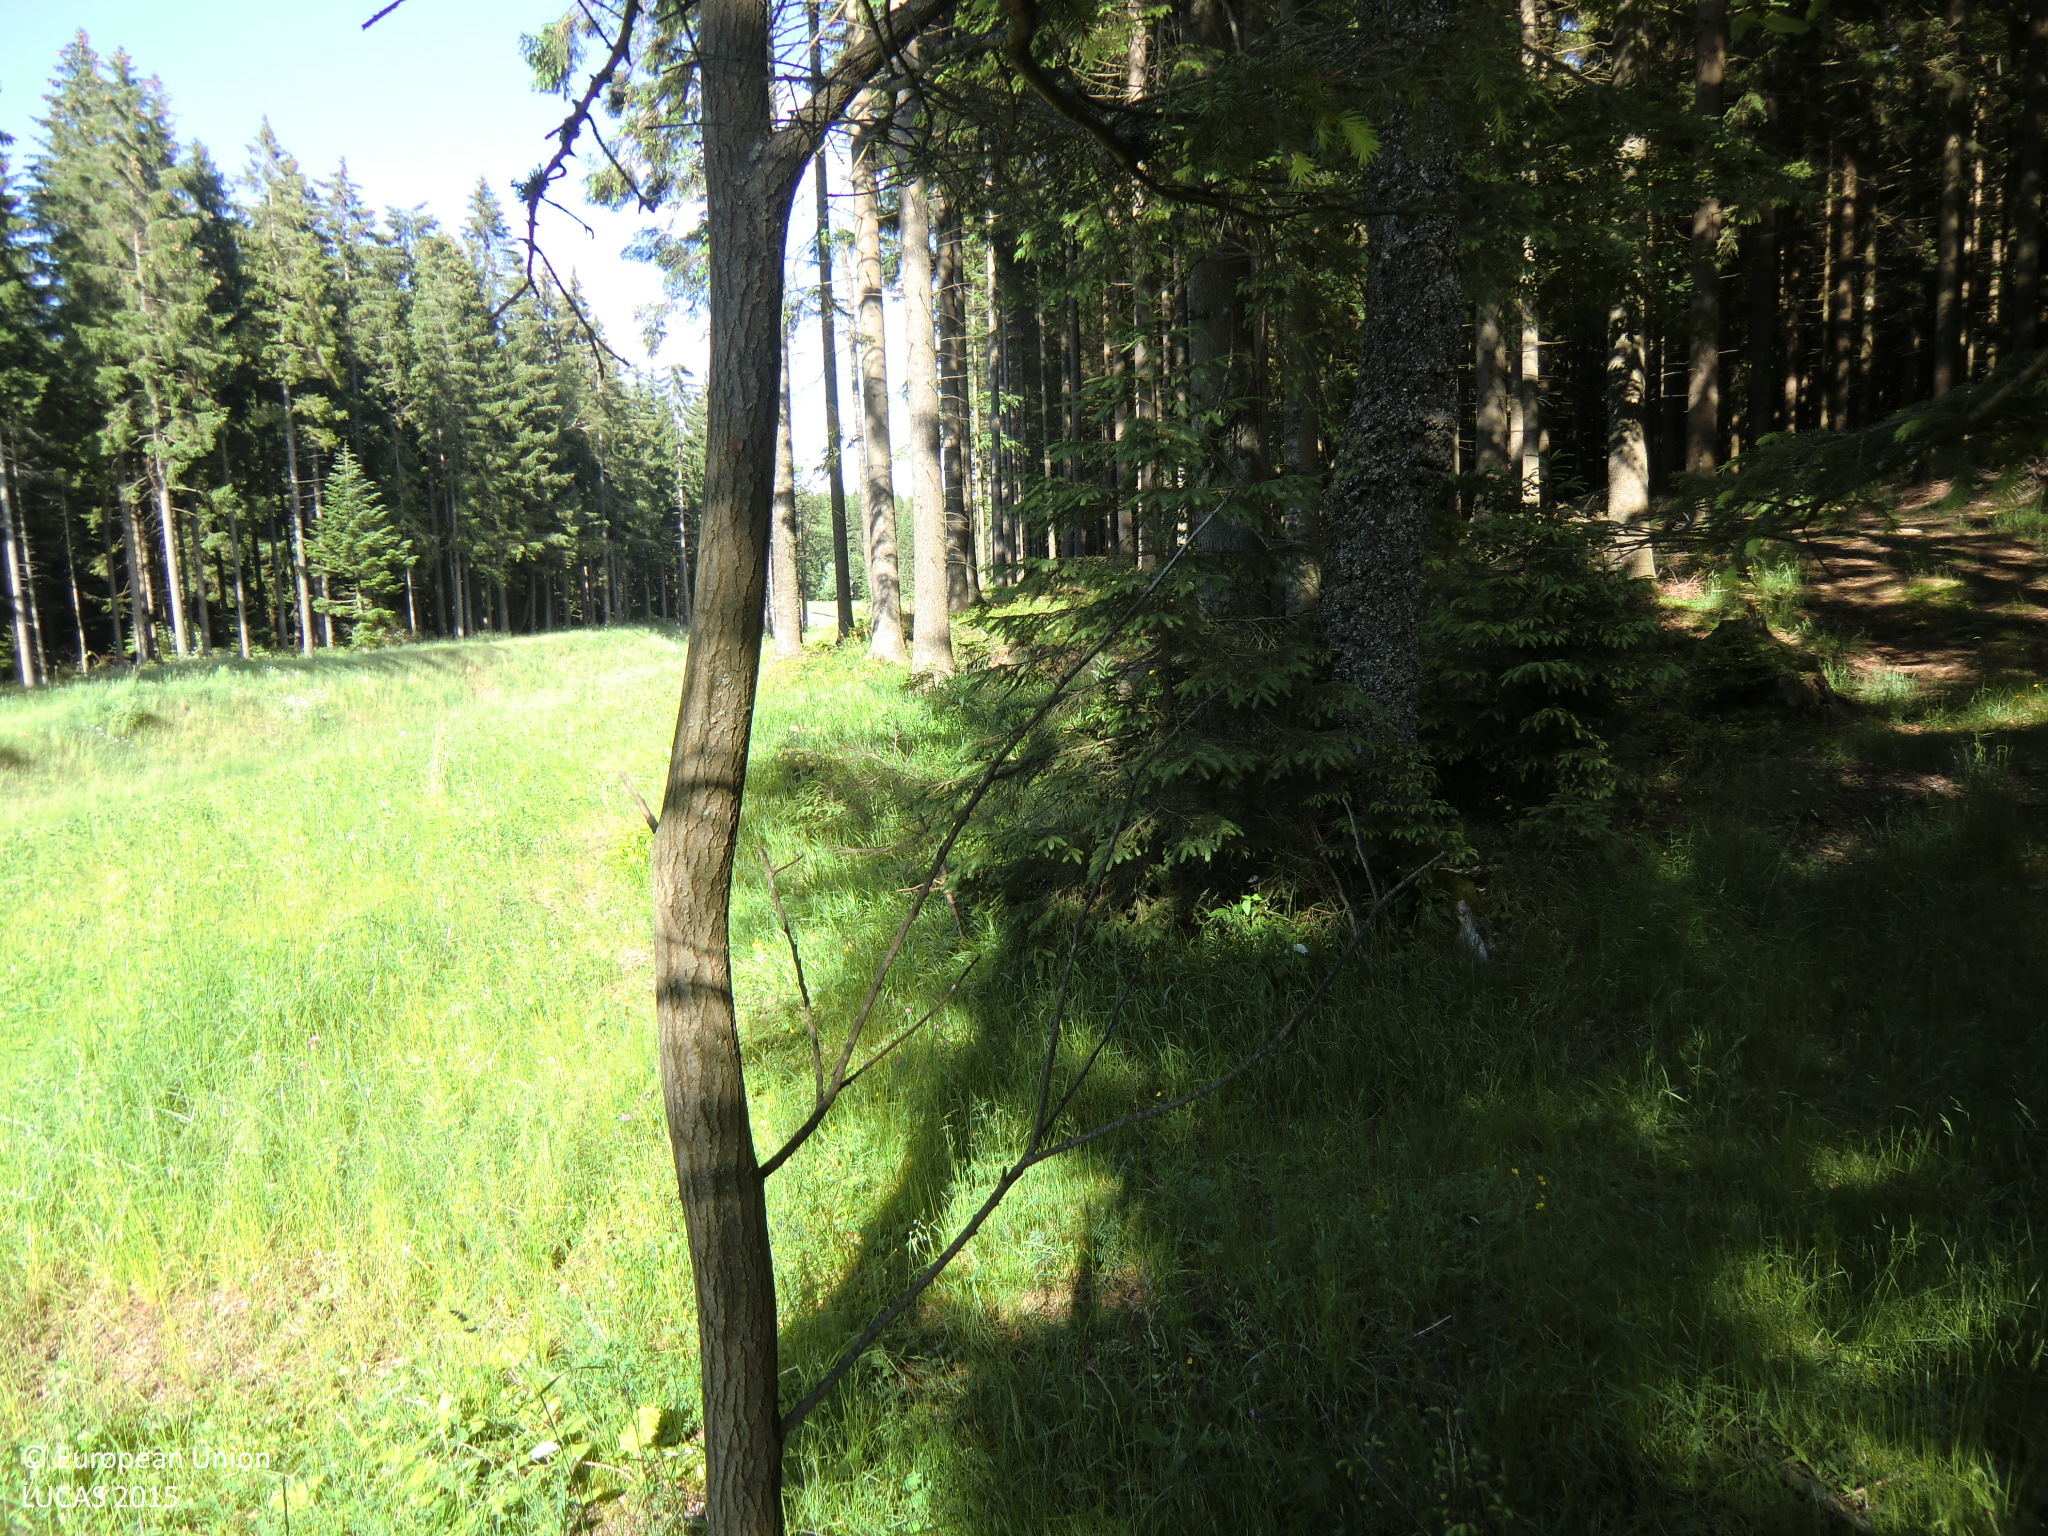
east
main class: Woodland
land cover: Spruce dominated coniferous woodland
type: hemiboreal forest and nemoral coniferous forest and mixed broadleaved-coniferous forest
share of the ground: > 75 %
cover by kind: coniferous forest trees 80 %, herbaceous plants 20 %
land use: Forestry
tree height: > 5 m
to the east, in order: Spruce dominated coniferous woodland; Spruce dominated mixed woodland; Tracks; Spruce dominated mixed woodland; Spruce dominated coniferous woodland; Tracks; Spruce dominated coniferous woodland; Tracks; Spruce dominated coniferous woodland
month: June
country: AT
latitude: 48.5558
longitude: 14.7025
